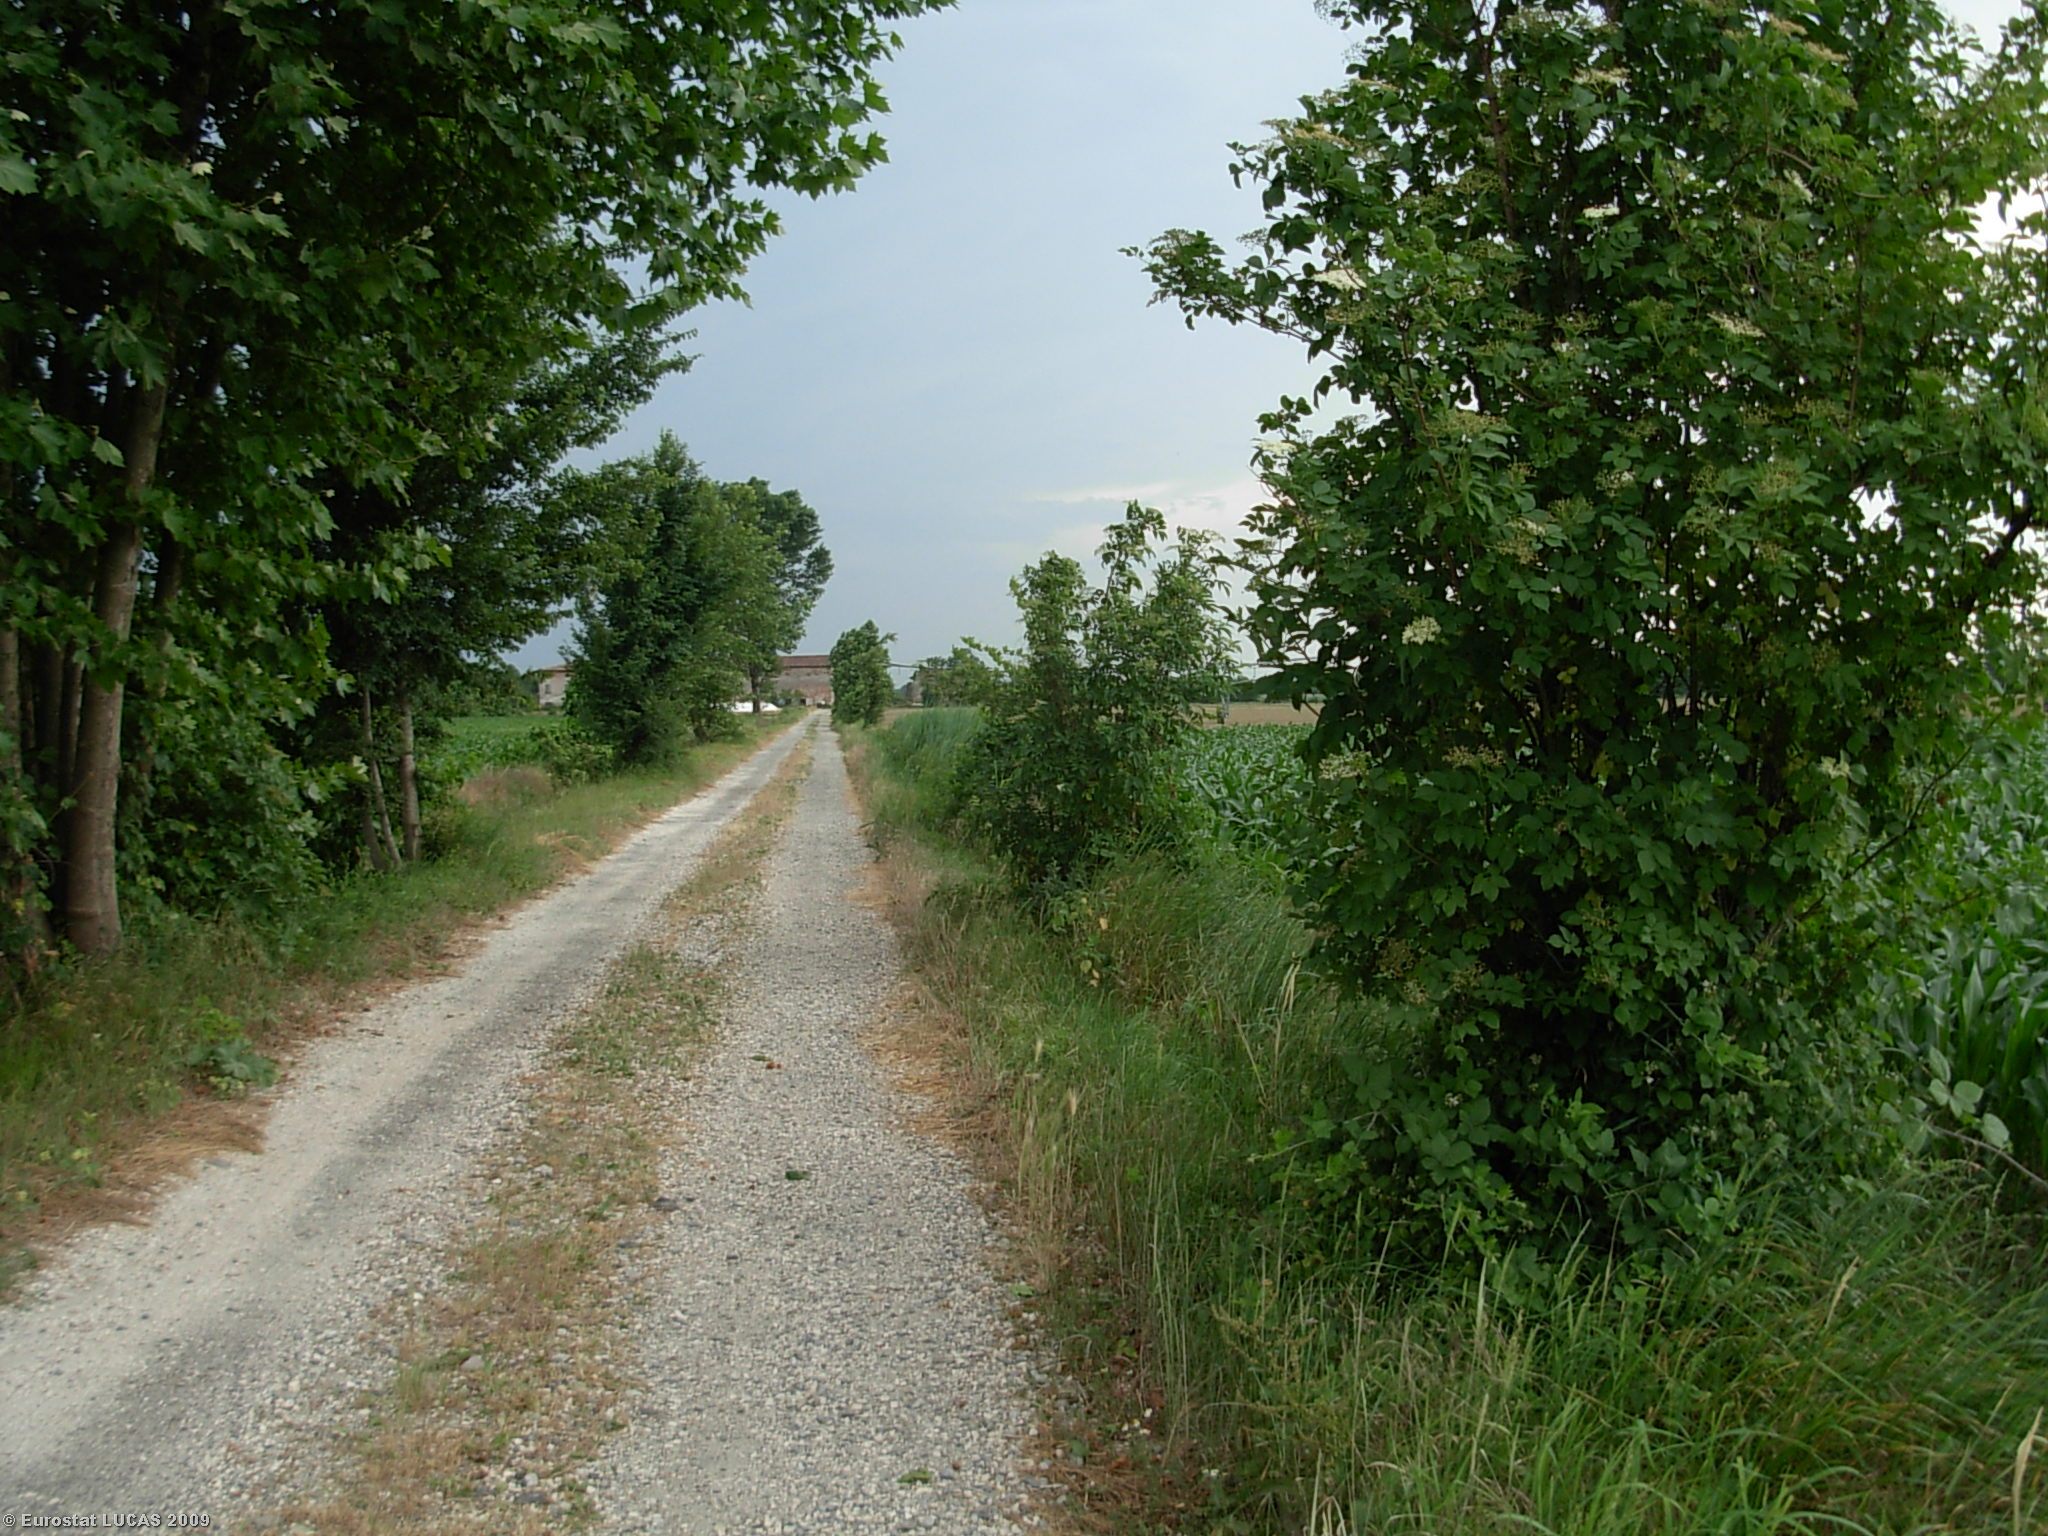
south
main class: Cropland
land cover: Maize
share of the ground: > 75 %
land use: Agriculture (excluding fallow land and kitchen gardens)
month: May
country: IT
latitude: 45.3963
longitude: 10.0382
